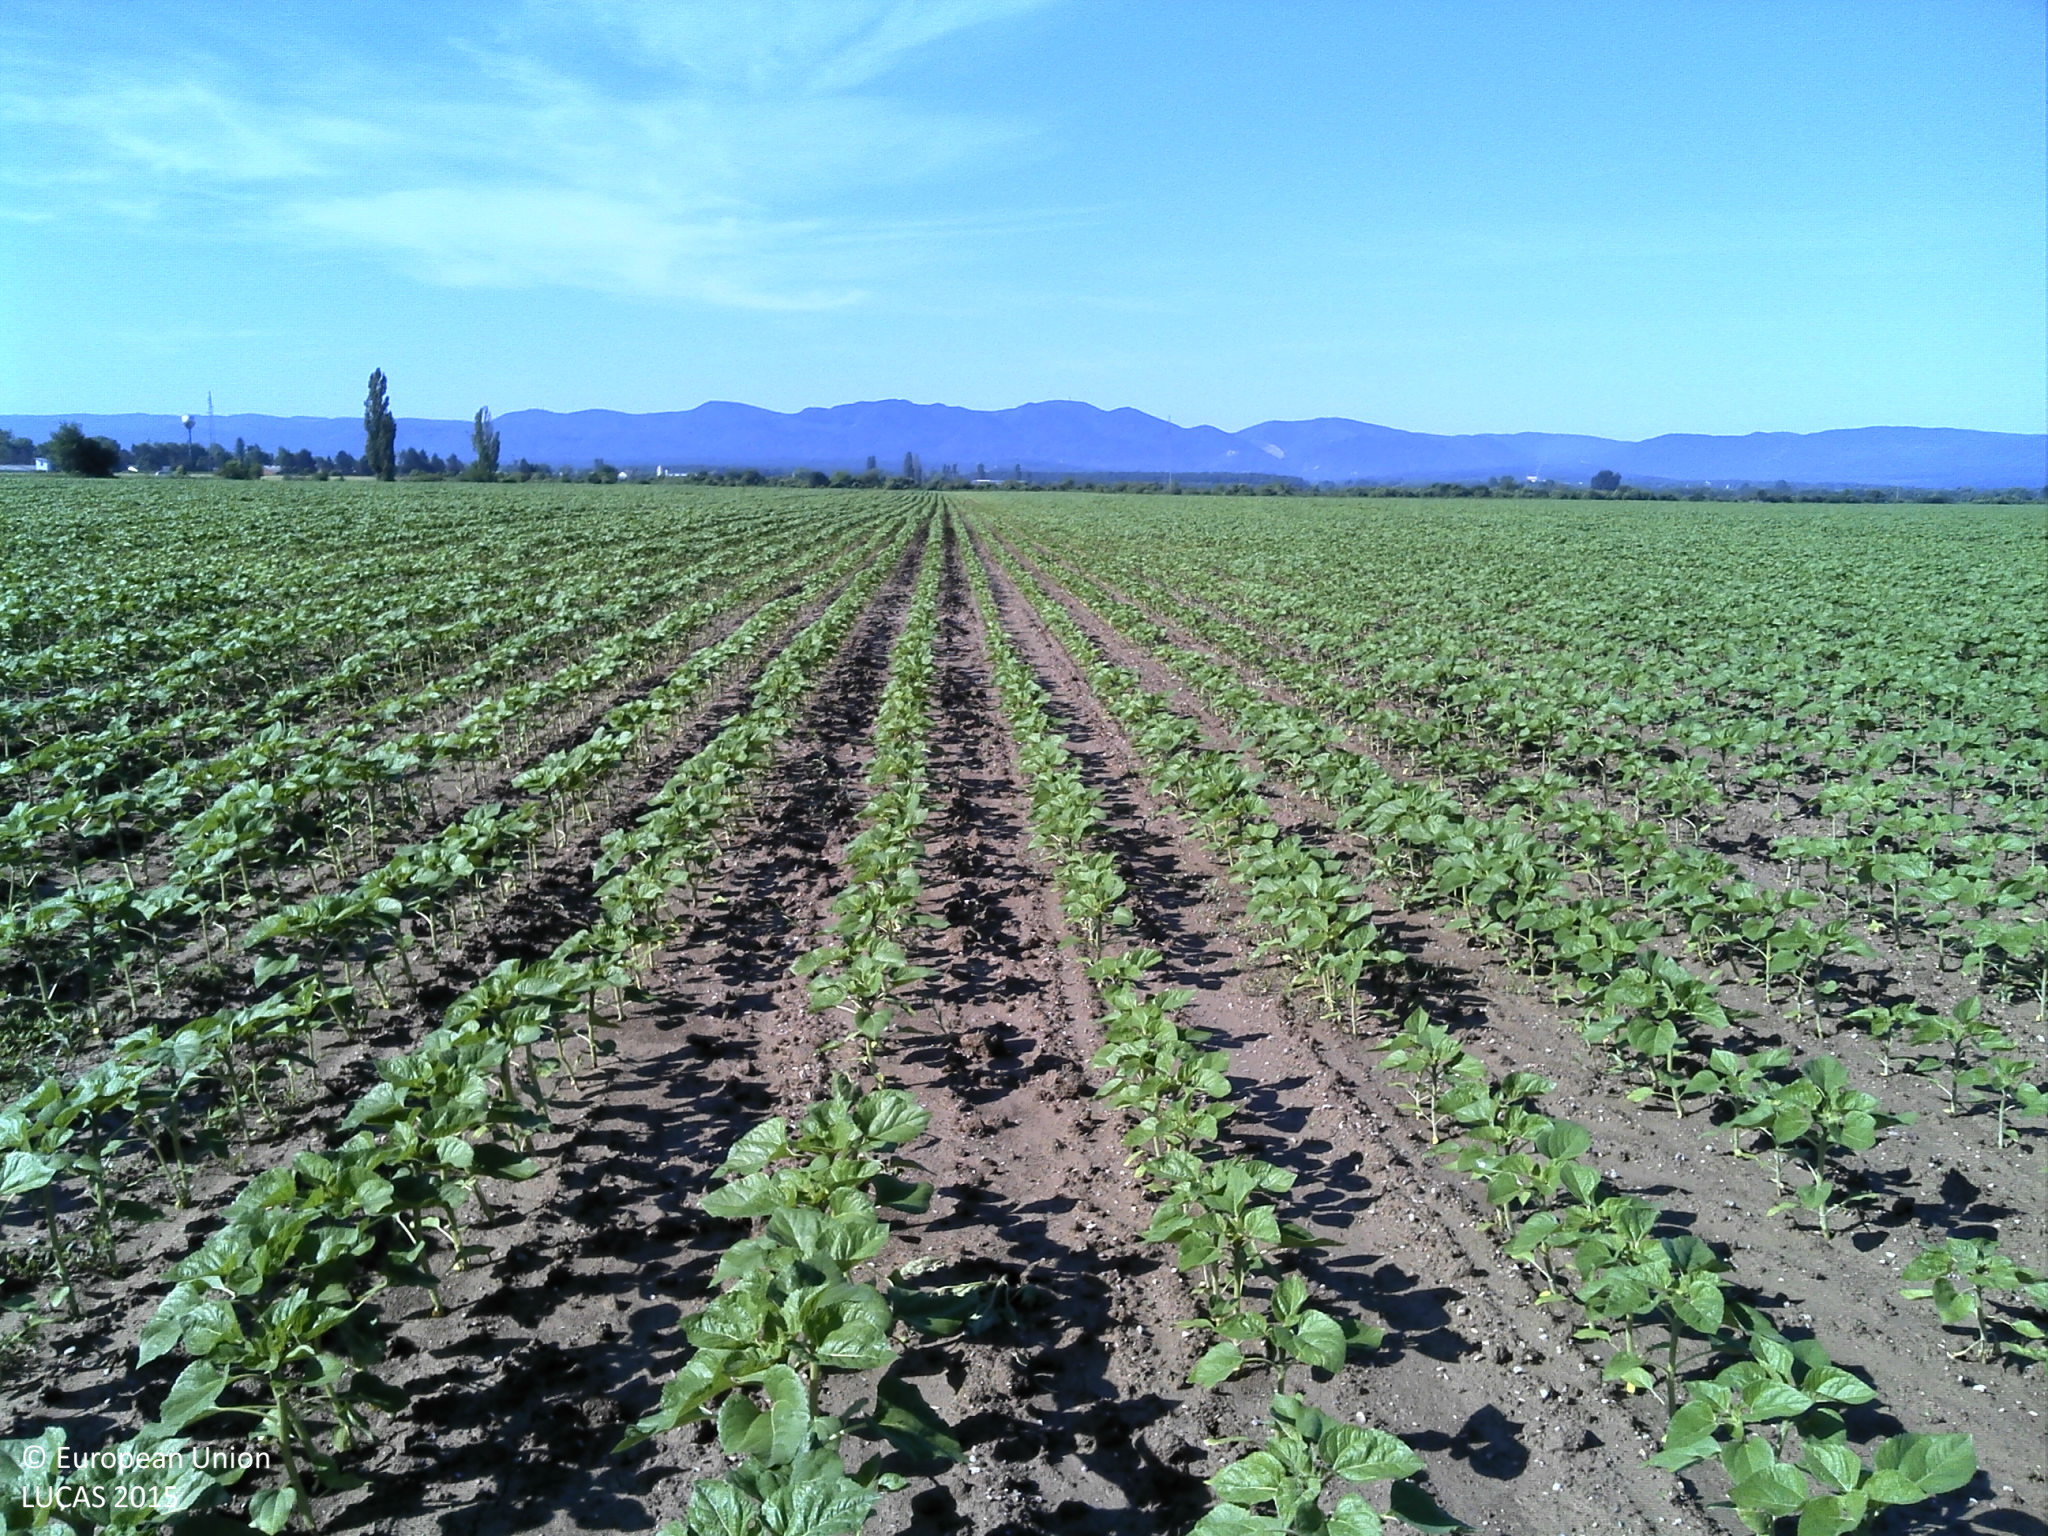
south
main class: Cropland
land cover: Sunflower
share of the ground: 25 - 50 %
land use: Agriculture (excluding fallow land and kitchen gardens)
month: May
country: HR
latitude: 45.5854
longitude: 17.9375
